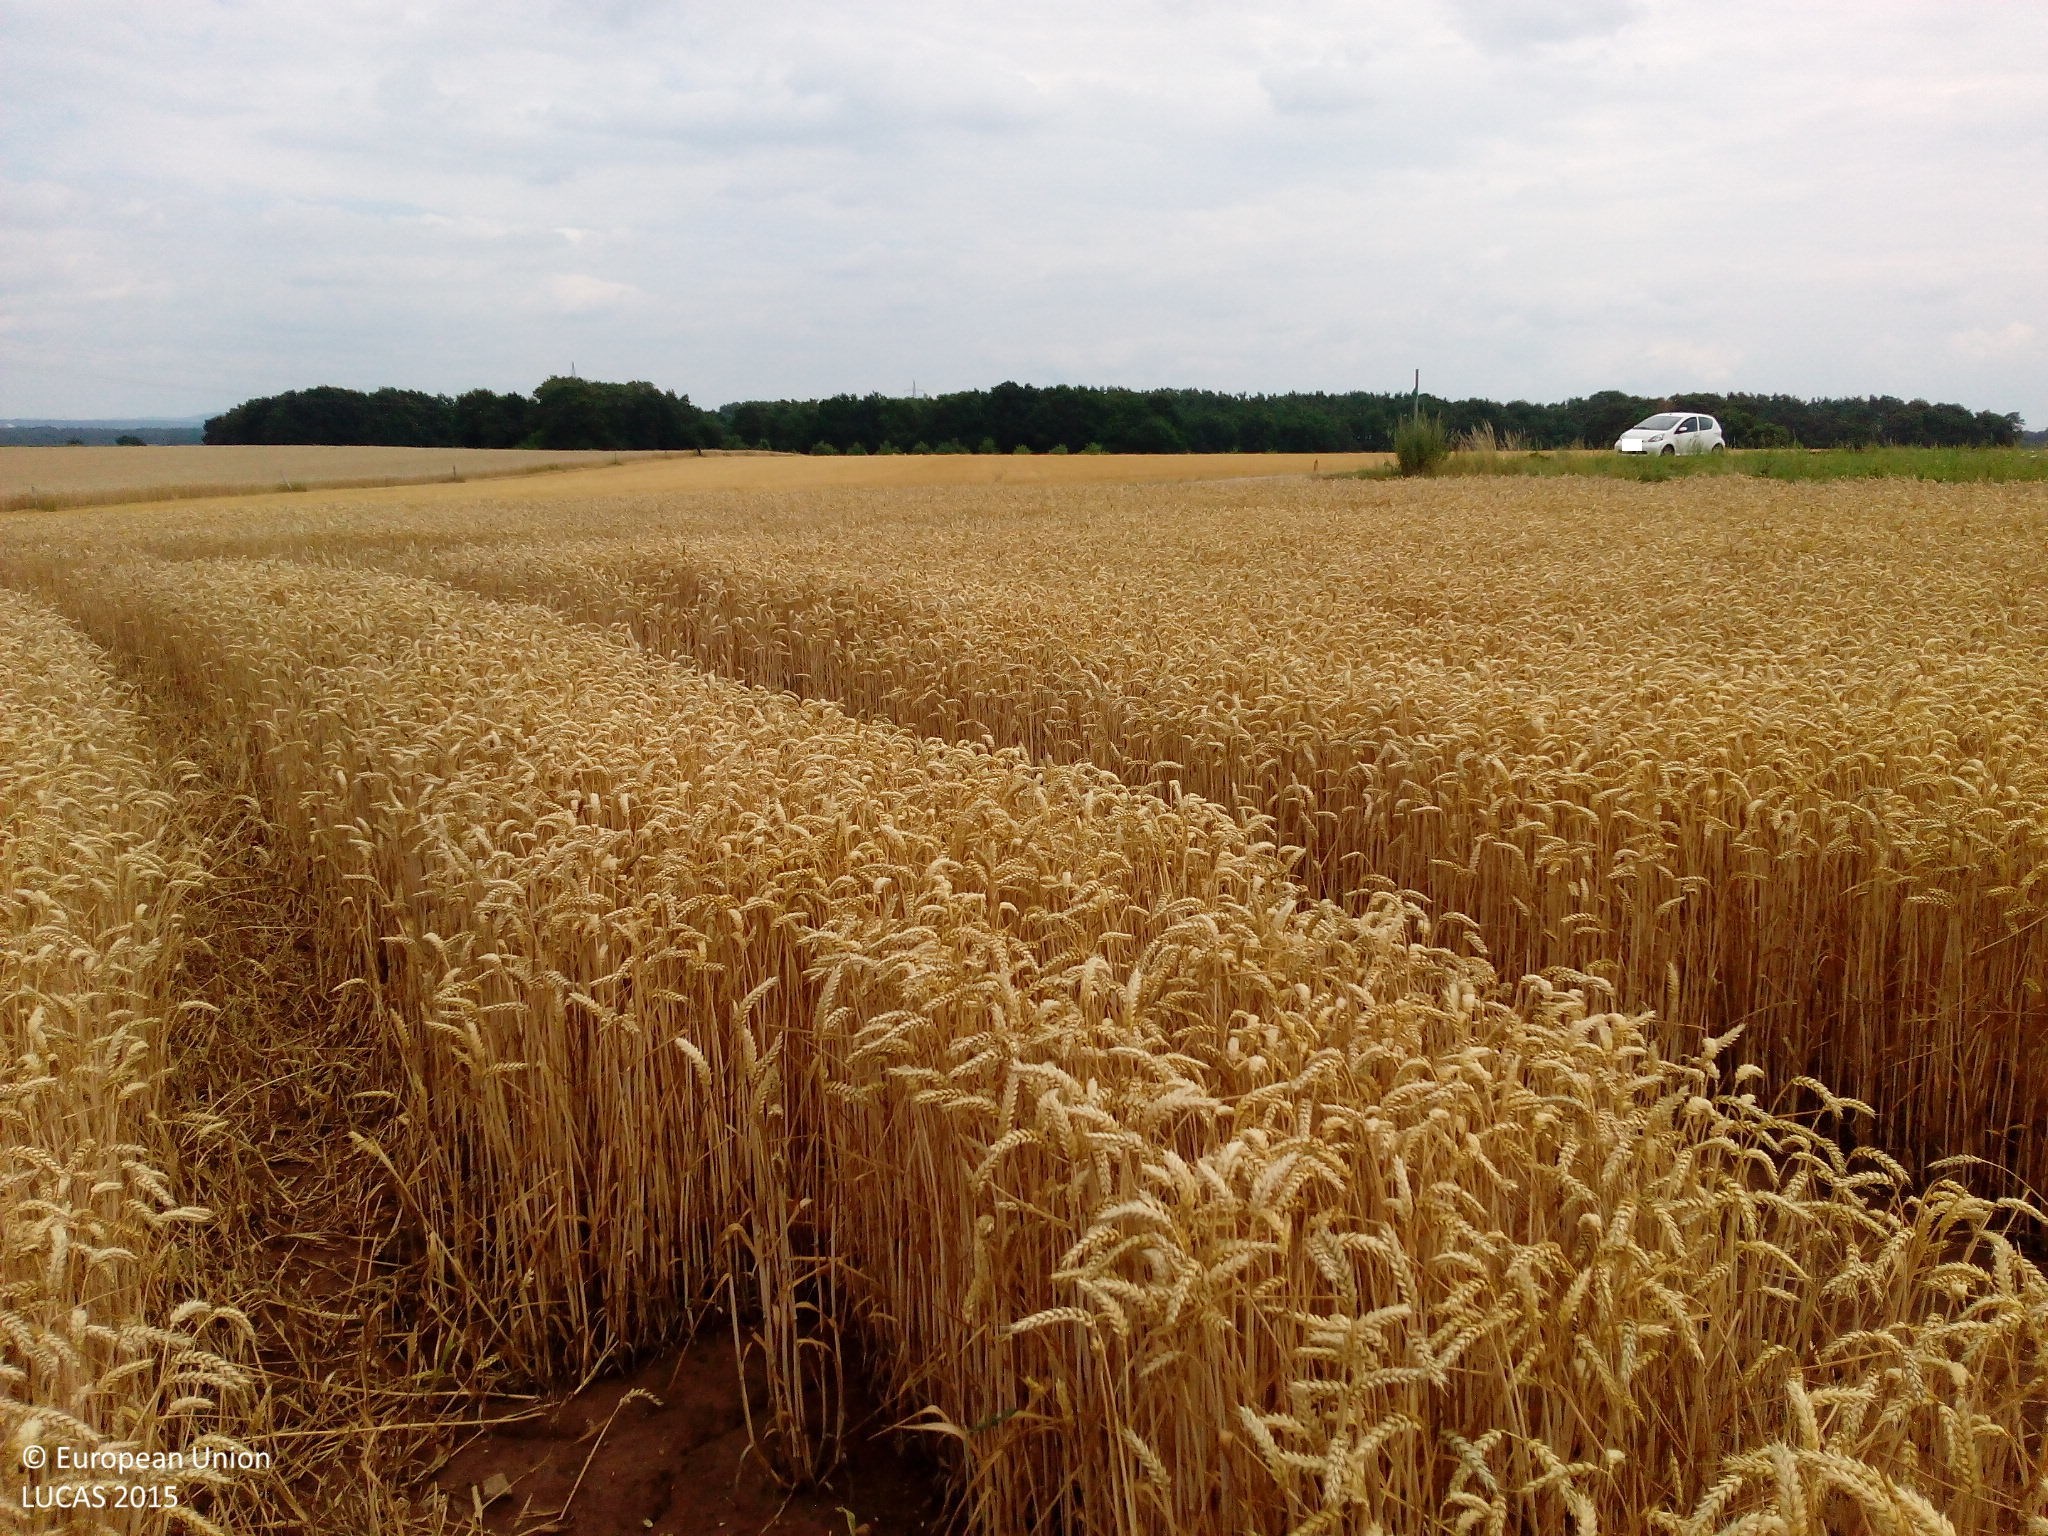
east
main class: Cropland
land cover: Common wheat
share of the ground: > 75 %
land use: Agriculture (excluding fallow land and kitchen gardens)
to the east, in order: Common wheat; Grass margins; Tracks; Grass margins; Barley
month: July
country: DE
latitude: 49.5512
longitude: 10.8981
